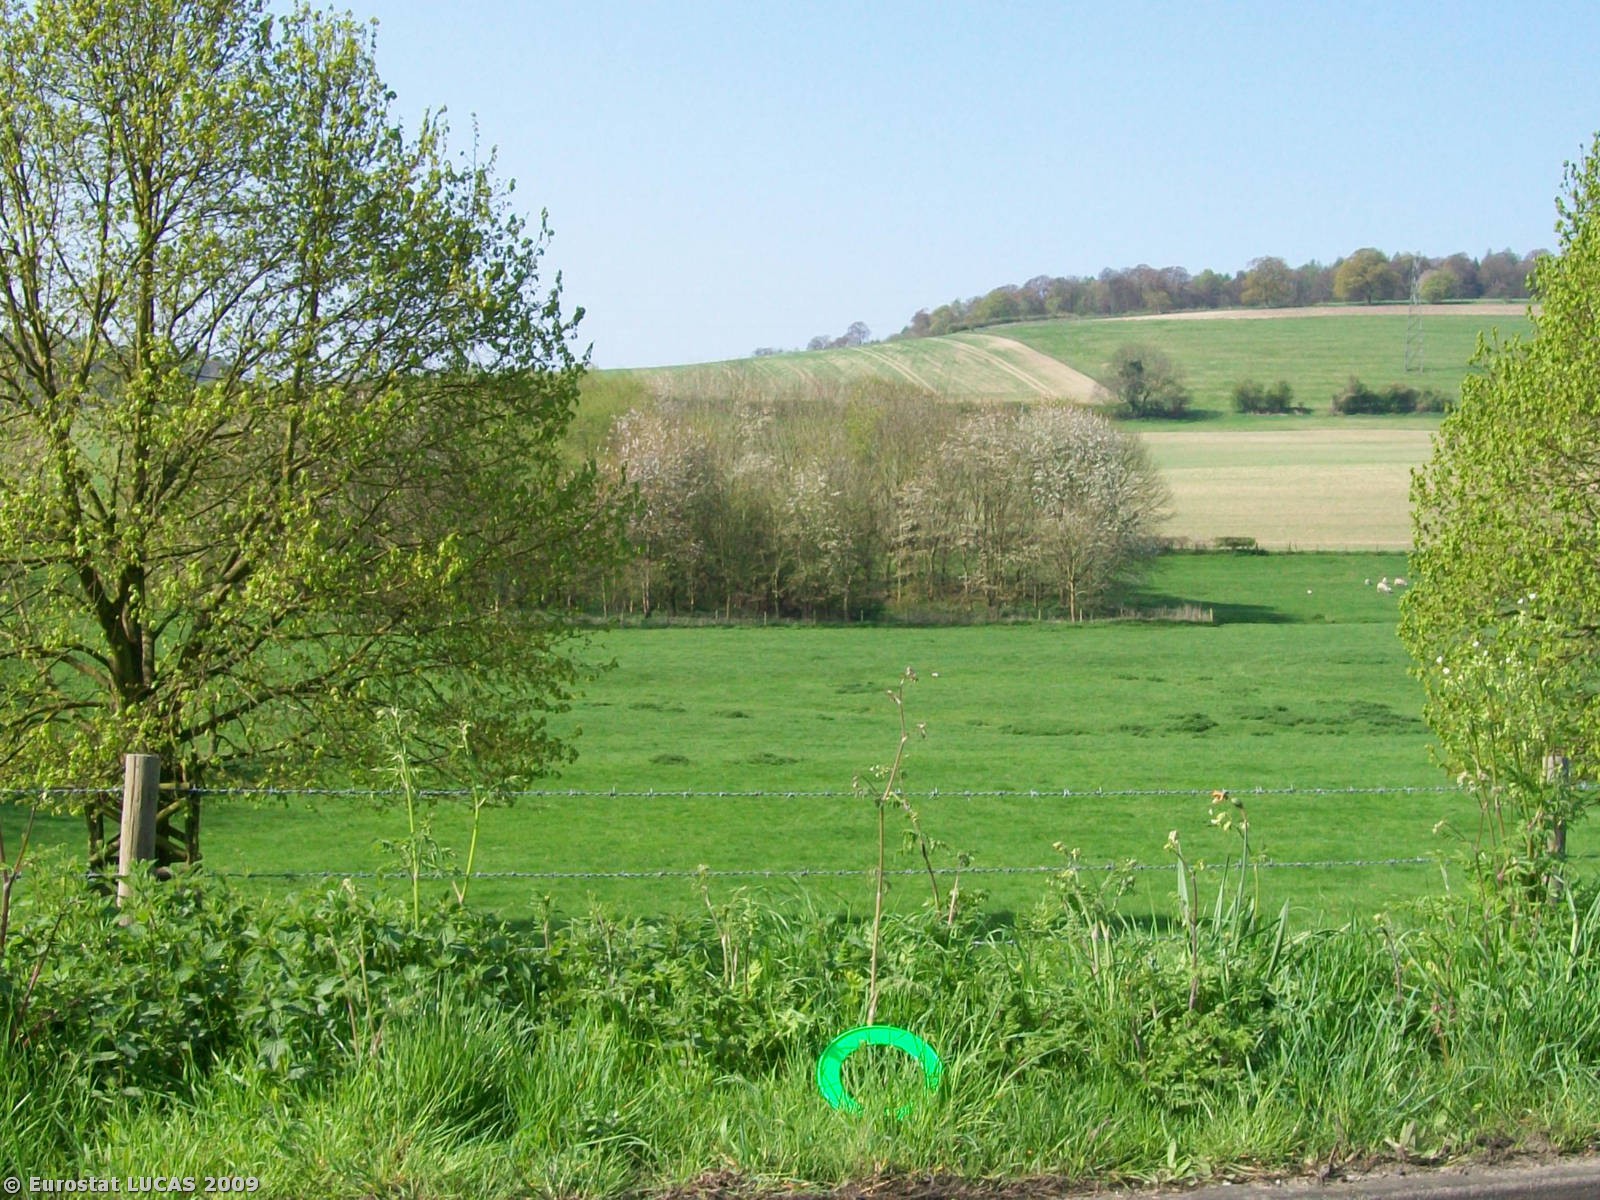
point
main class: Grassland
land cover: Grassland with sparse tree/shrub cover
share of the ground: > 75 %
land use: Agriculture (excluding fallow land and kitchen gardens)
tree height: < 5 m
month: April
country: GB
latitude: 51.6465
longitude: -0.8088
